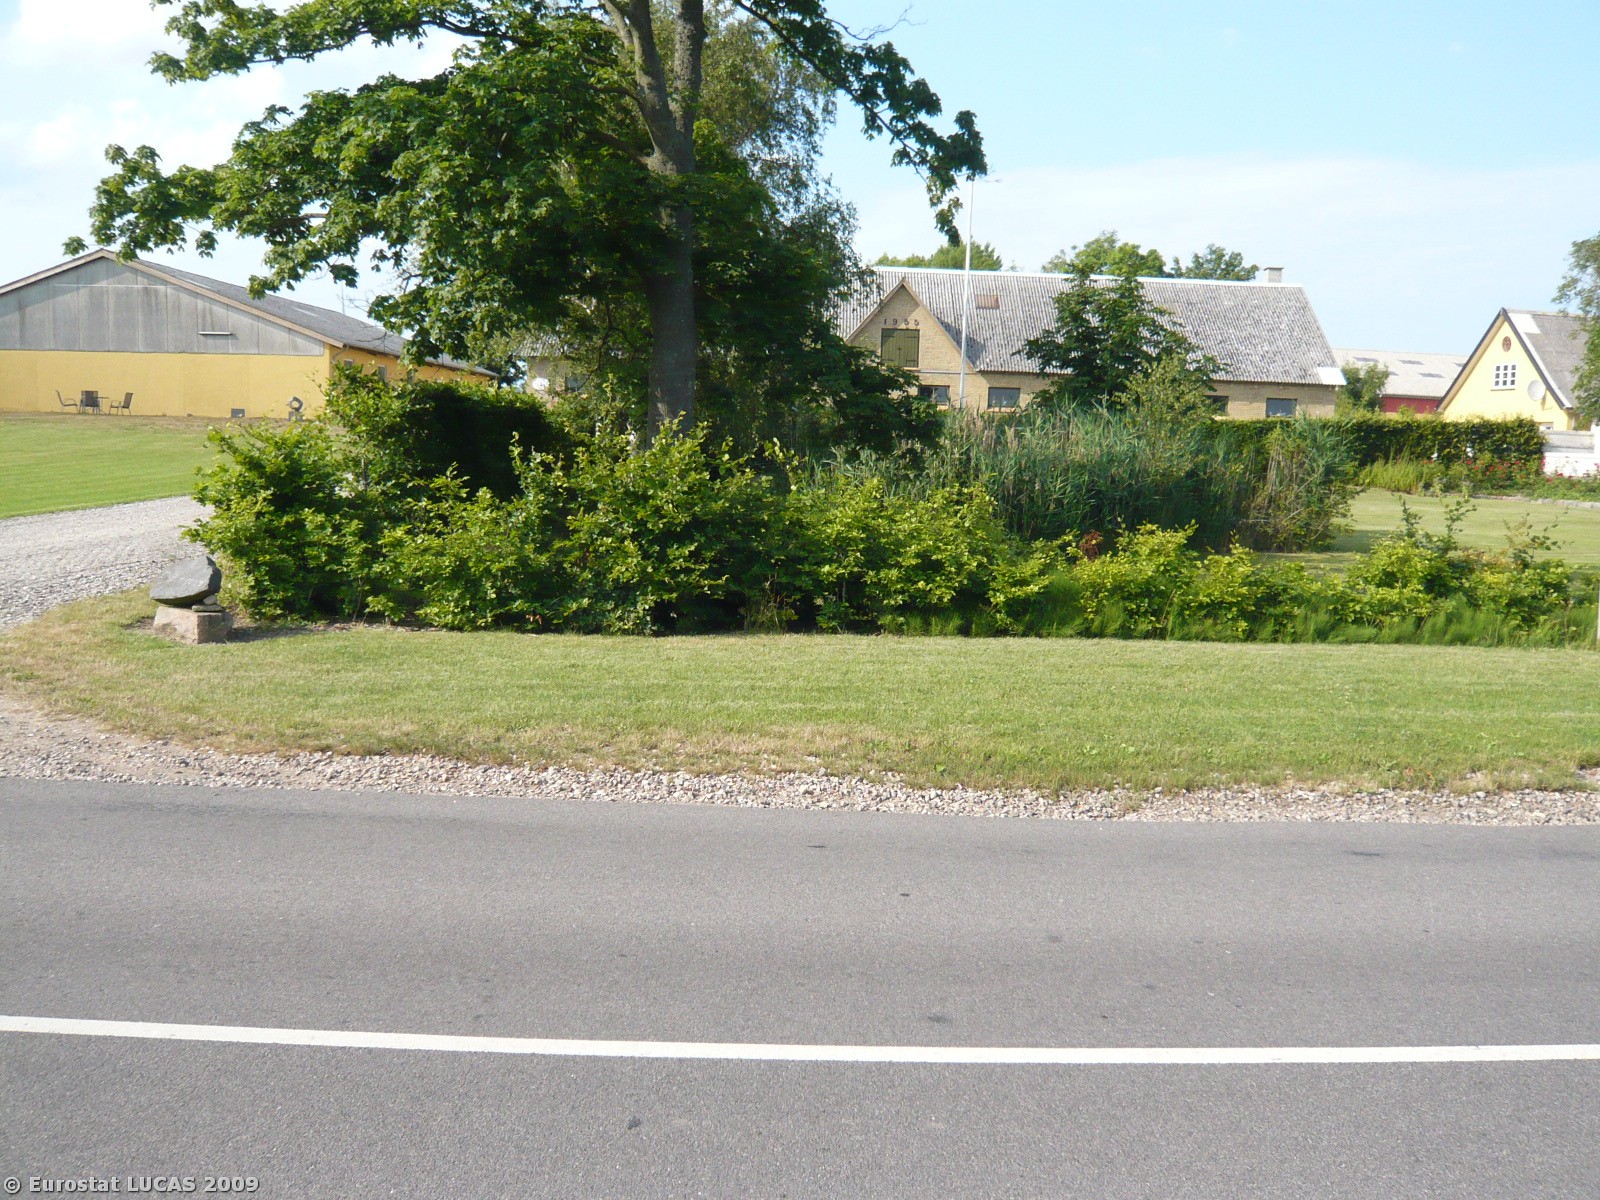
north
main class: Cropland
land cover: Dry pulses
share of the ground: > 75 %
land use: Agriculture (excluding fallow land and kitchen gardens)
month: July
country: DK
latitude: 55.8356
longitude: 11.6430
